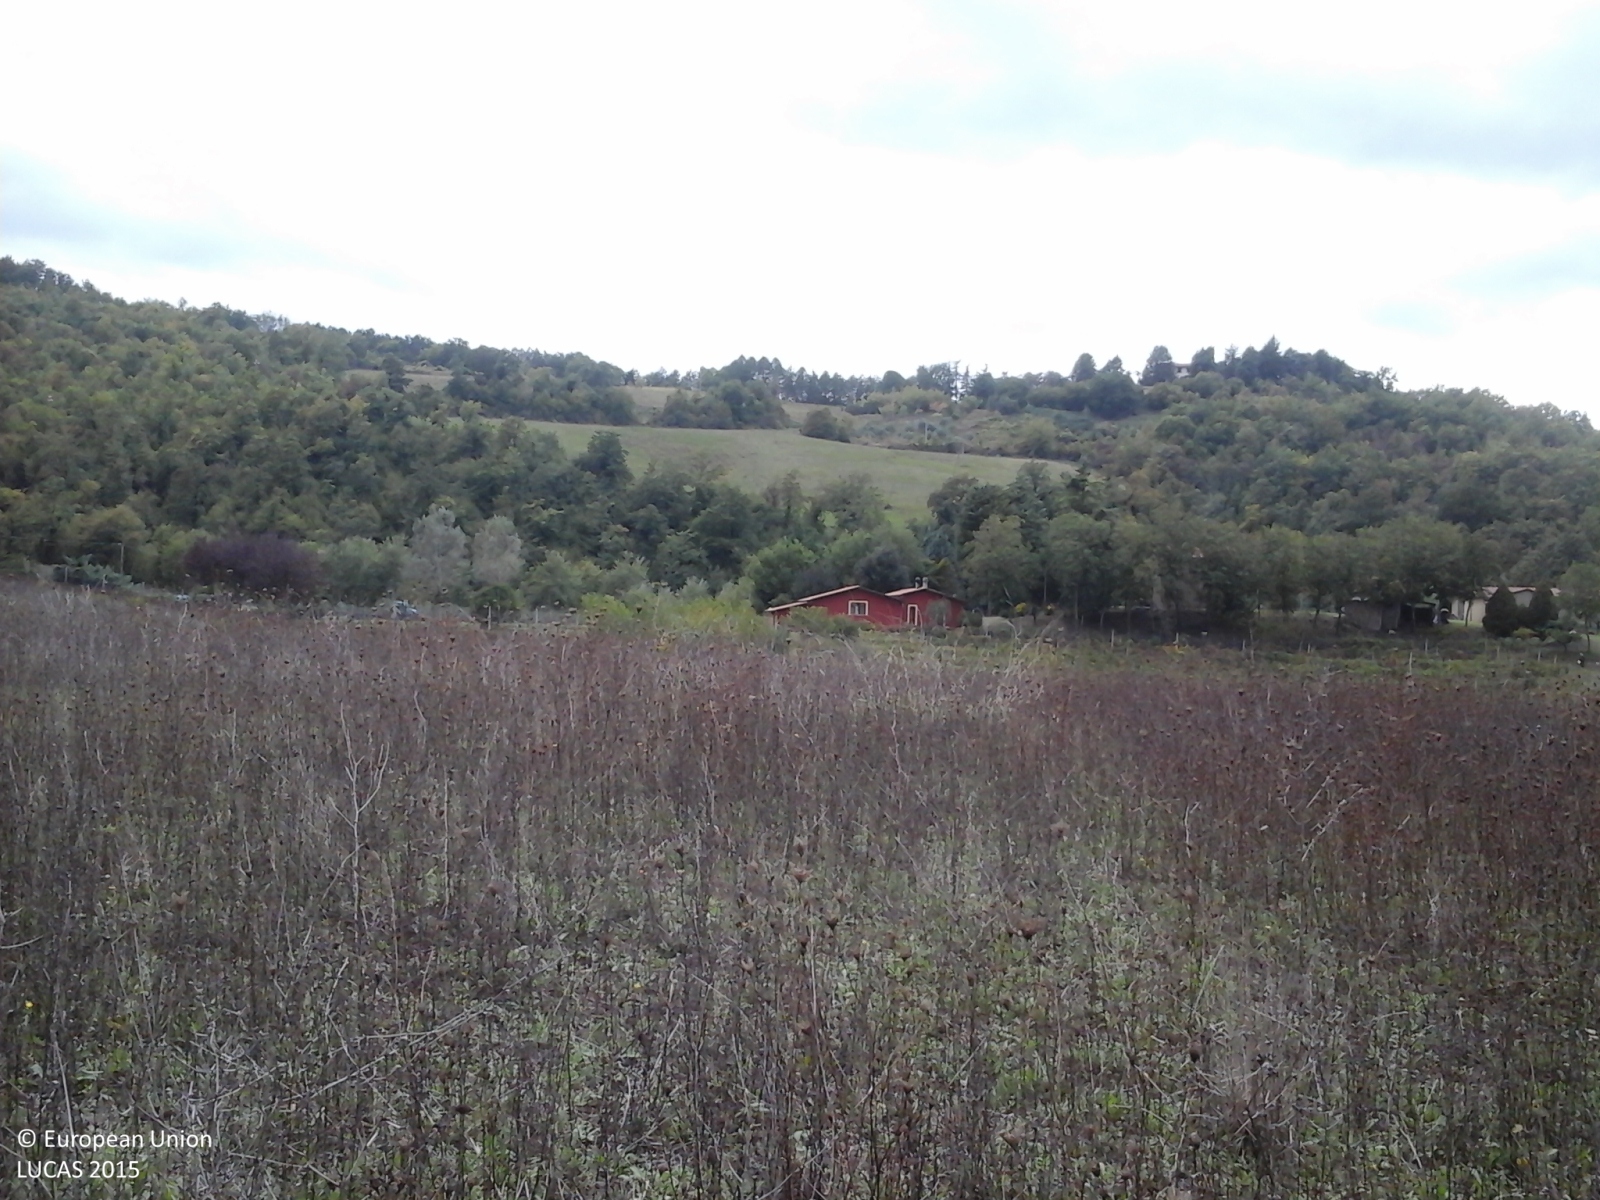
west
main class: Grassland
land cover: Spontaneously vegetated surfaces
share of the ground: > 75 %
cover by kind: herbaceous plants 100 %
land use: Abandoned areas
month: October
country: IT
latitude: 43.1810
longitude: 12.5886
